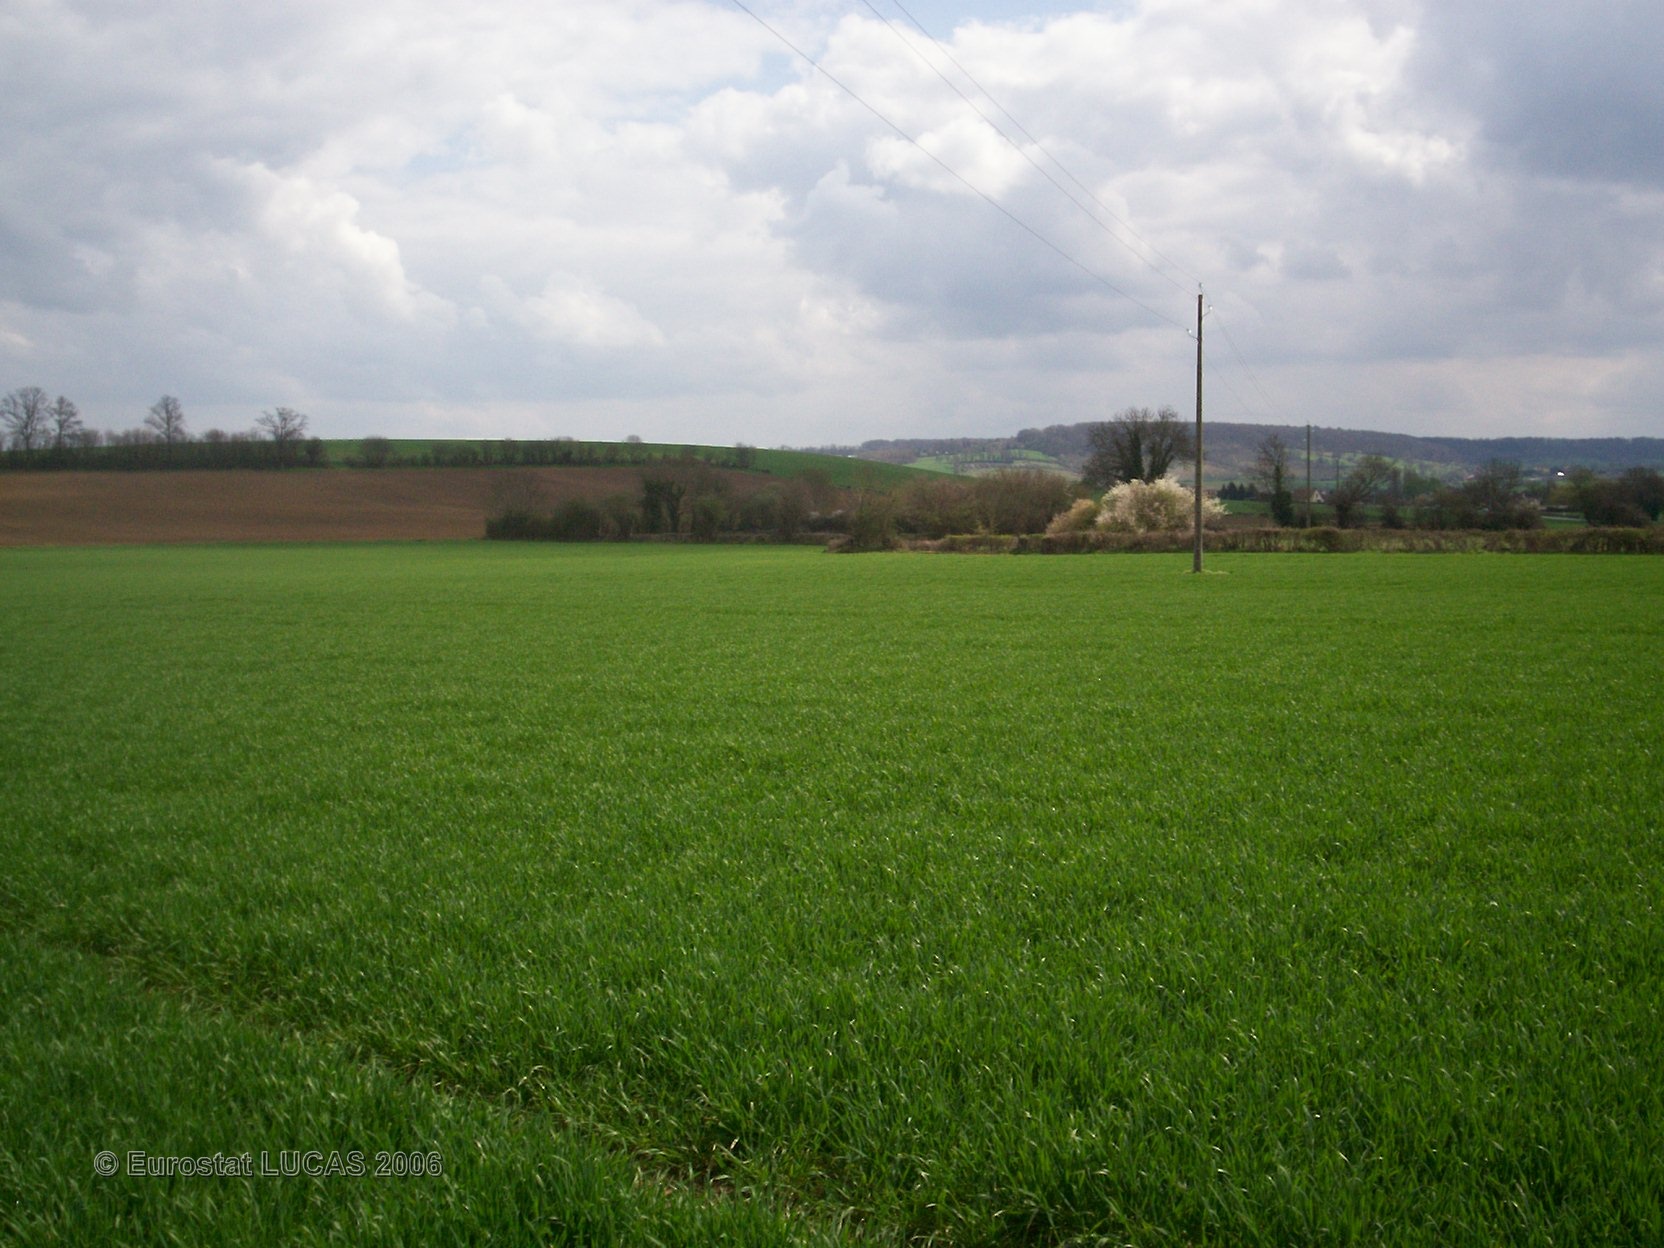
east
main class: Cropland
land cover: Common wheat
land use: Agriculture (excluding fallow land and kitchen gardens)
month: April
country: FR
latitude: 49.0187
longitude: 0.0009
